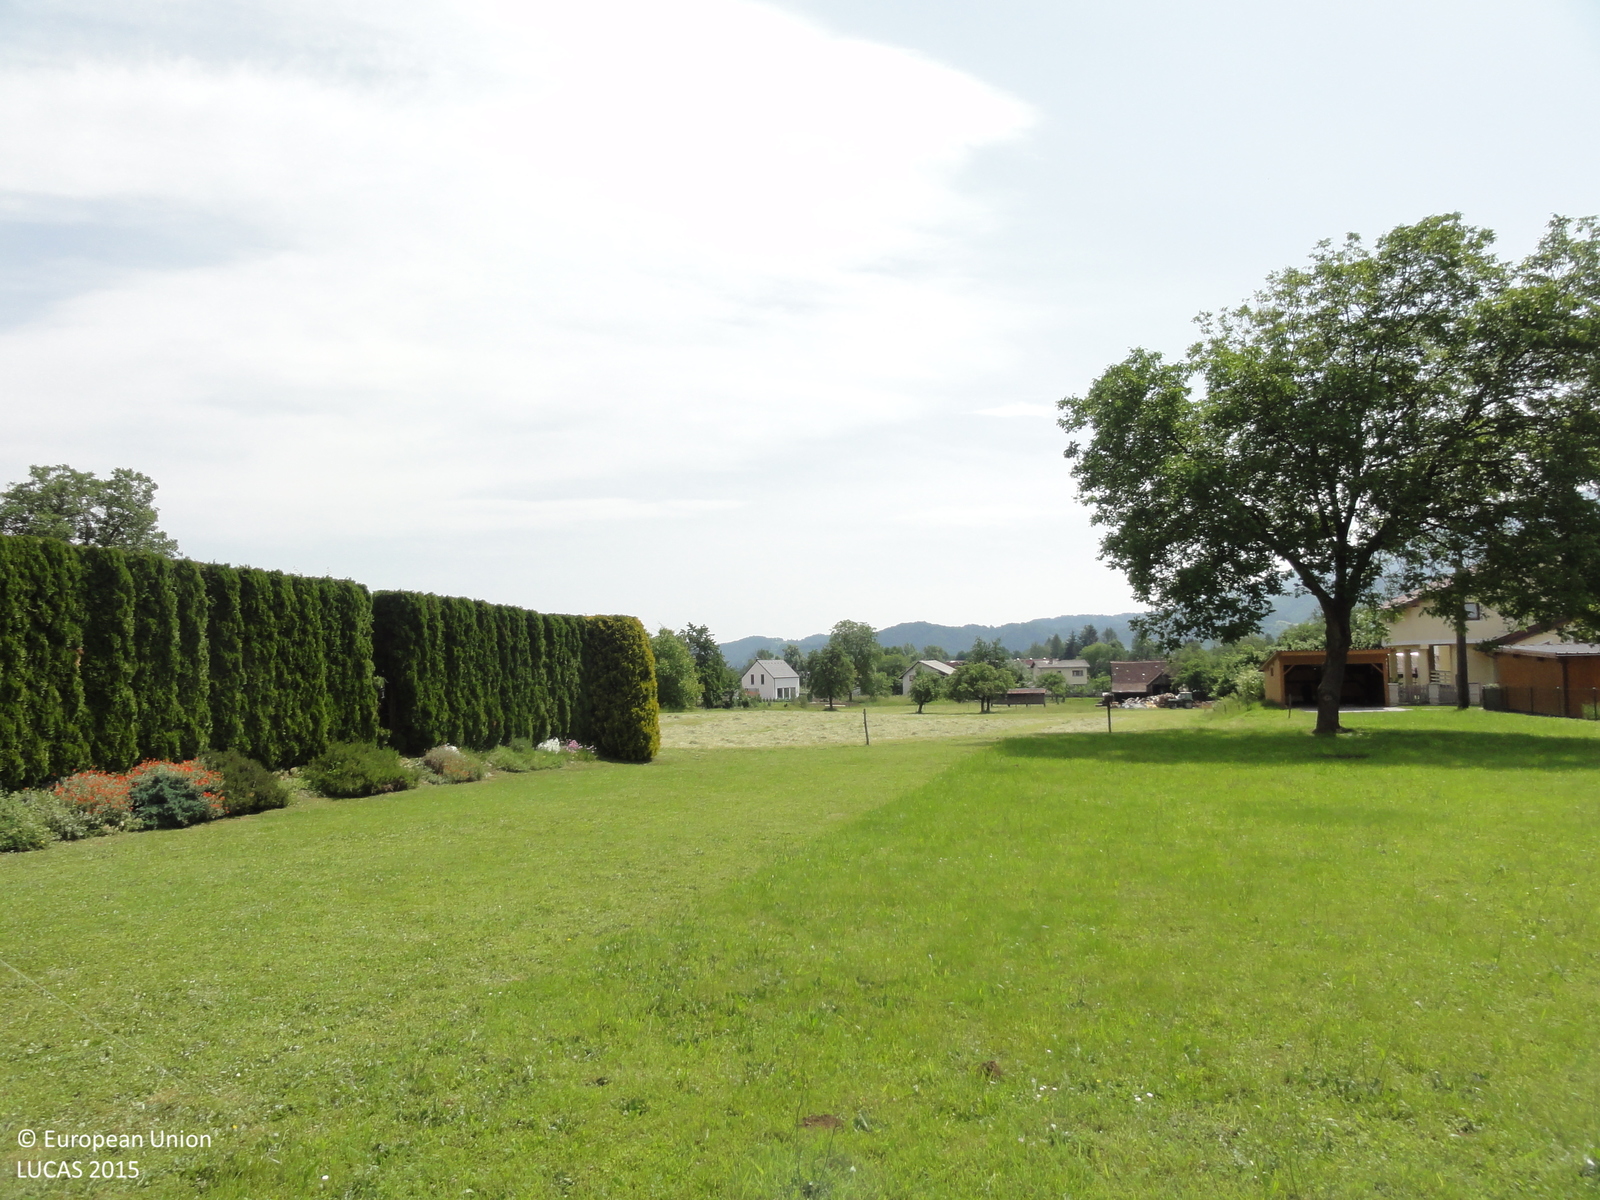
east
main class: Grassland
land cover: Grassland without tree/shrub cover
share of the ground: > 75 %
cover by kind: herbaceous plants 100 %
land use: Agriculture (excluding fallow land and kitchen gardens)
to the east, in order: Grassland without tree/shrub cover; Fences; Grassland without tree/shrub cover; Inland fresh running water; Grass margins; Artificial constructions in urban areas
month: May
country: SI
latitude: 46.5532
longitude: 15.4899
